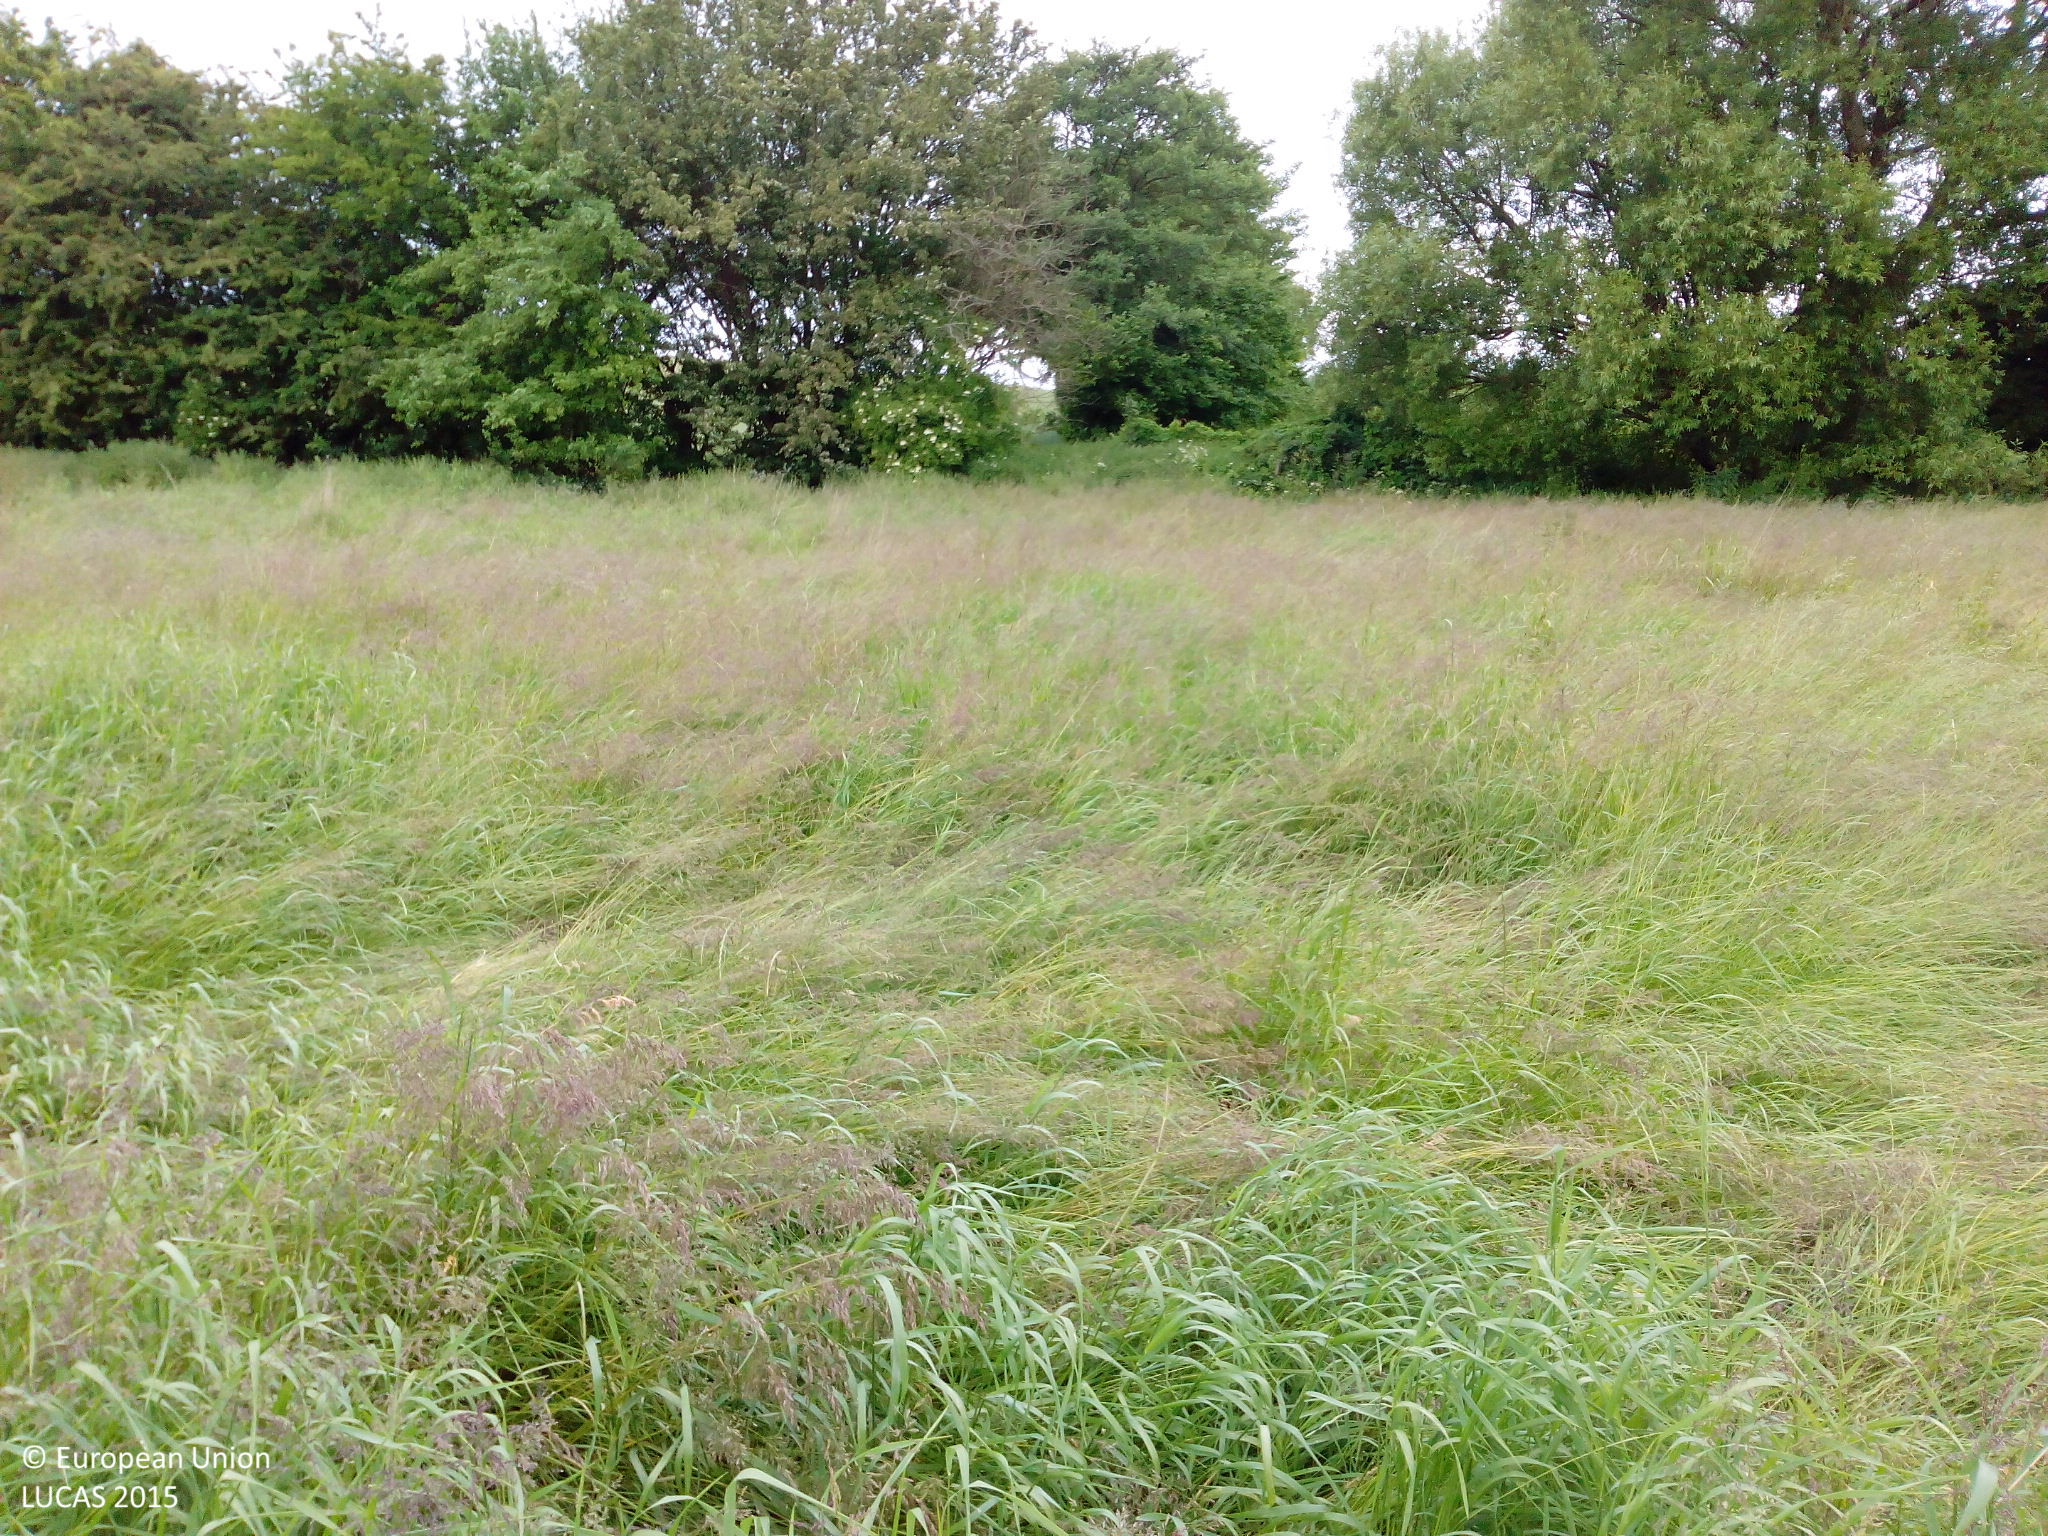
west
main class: Grassland
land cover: Spontaneously vegetated surfaces
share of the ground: > 75 %
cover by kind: herbaceous plants 100 %
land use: Semi-natural and natural areas not in use
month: June
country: DK
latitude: 54.9454
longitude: 10.7332
